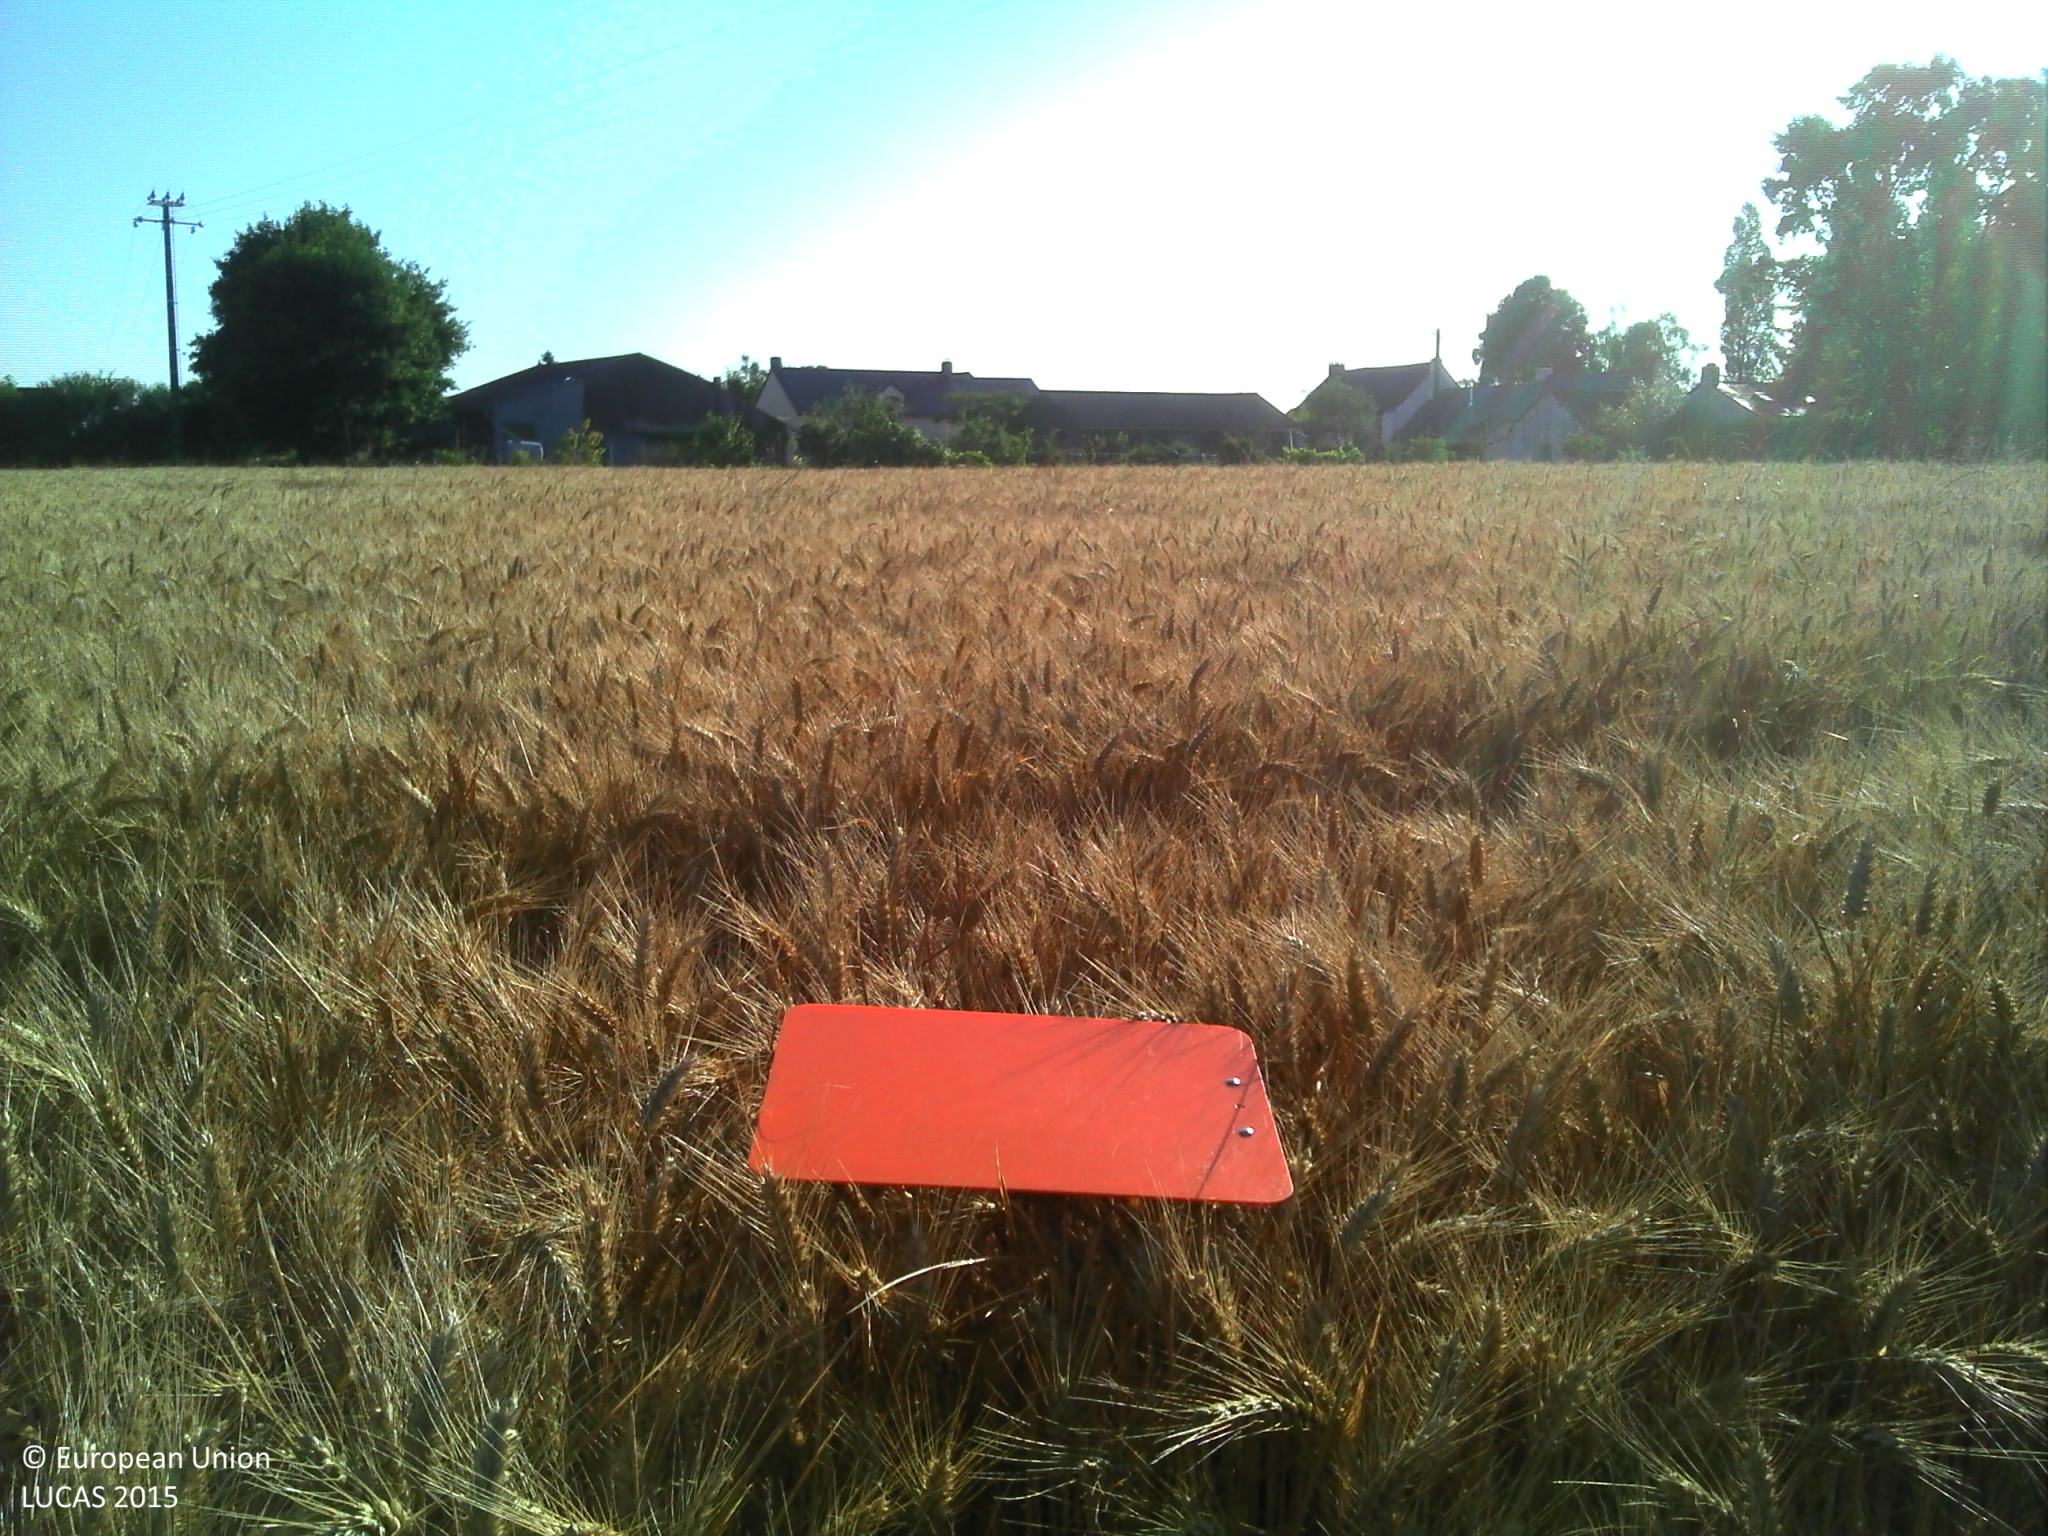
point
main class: Cropland
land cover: Common wheat
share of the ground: > 75 %
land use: Agriculture (excluding fallow land and kitchen gardens)
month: July
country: FR
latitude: 47.3421
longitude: -1.5444
